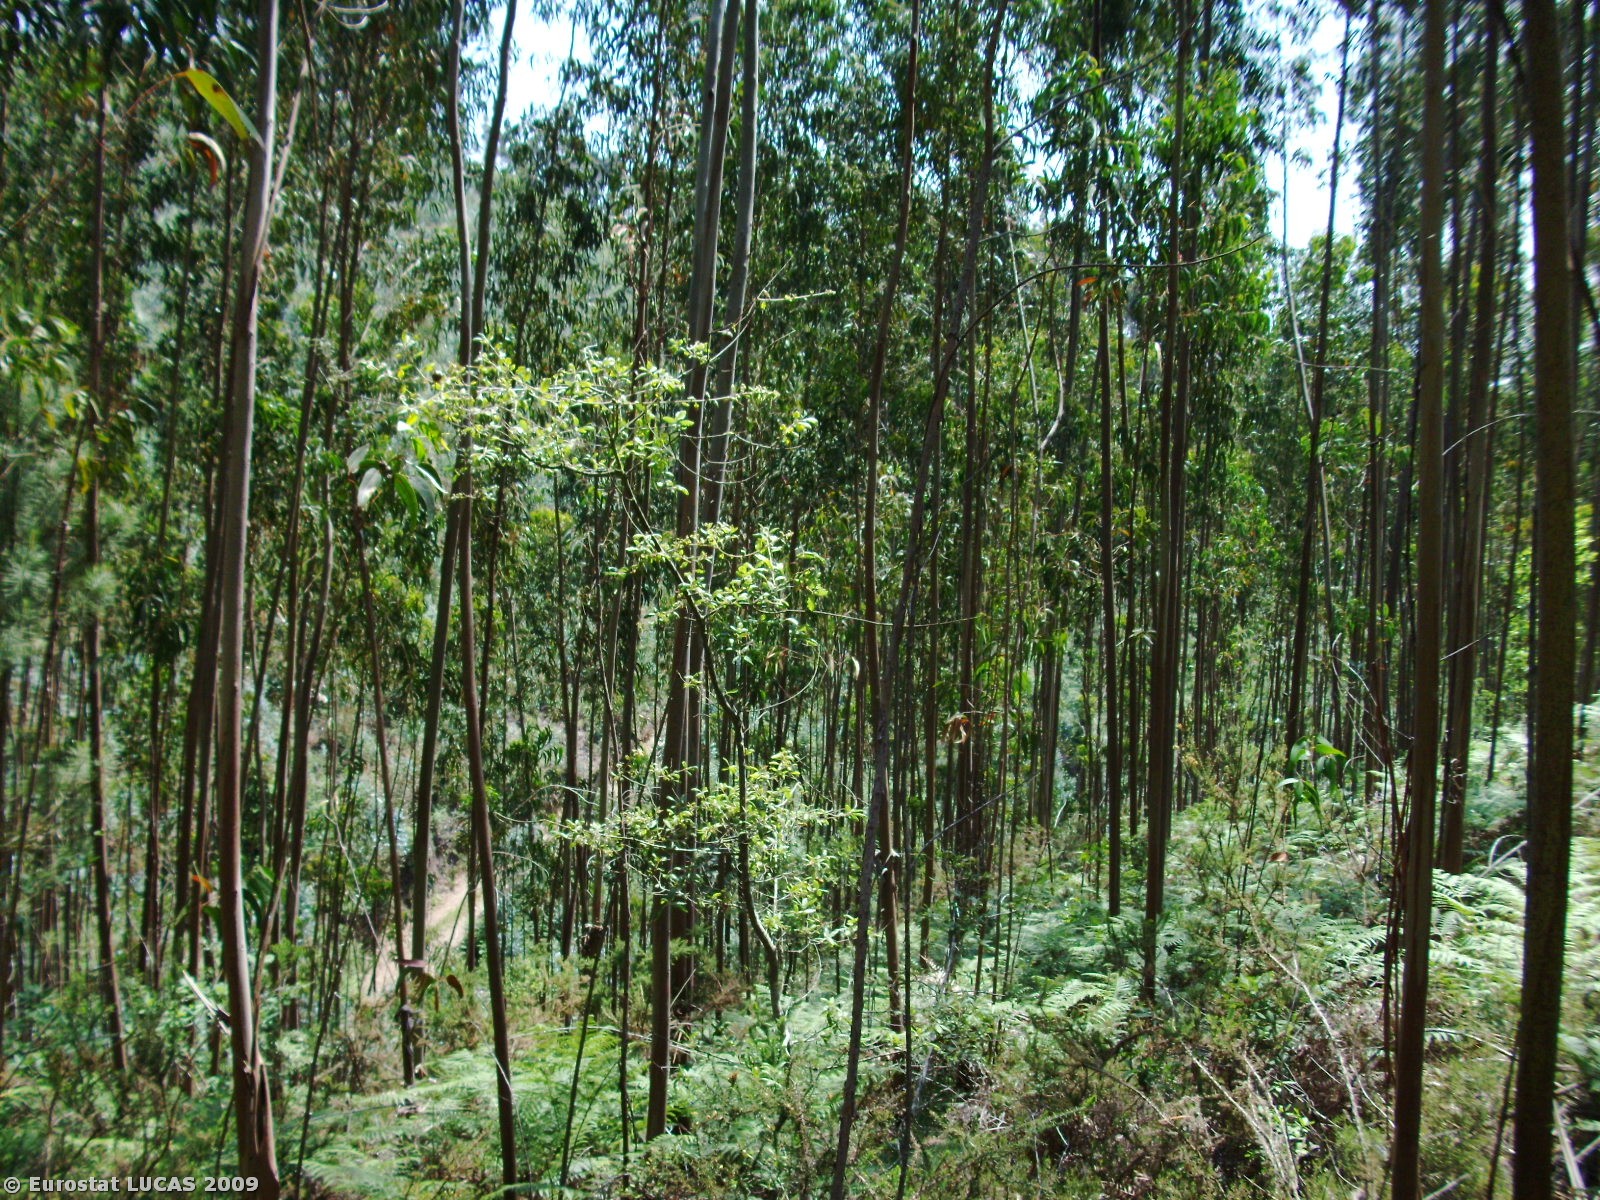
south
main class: Woodland
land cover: Broadleaved woodland
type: plantations and self-sown exotic forest
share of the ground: > 75 %
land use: Forestry
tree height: > 5 m
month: May
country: PT
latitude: 40.2684
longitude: -8.3931
